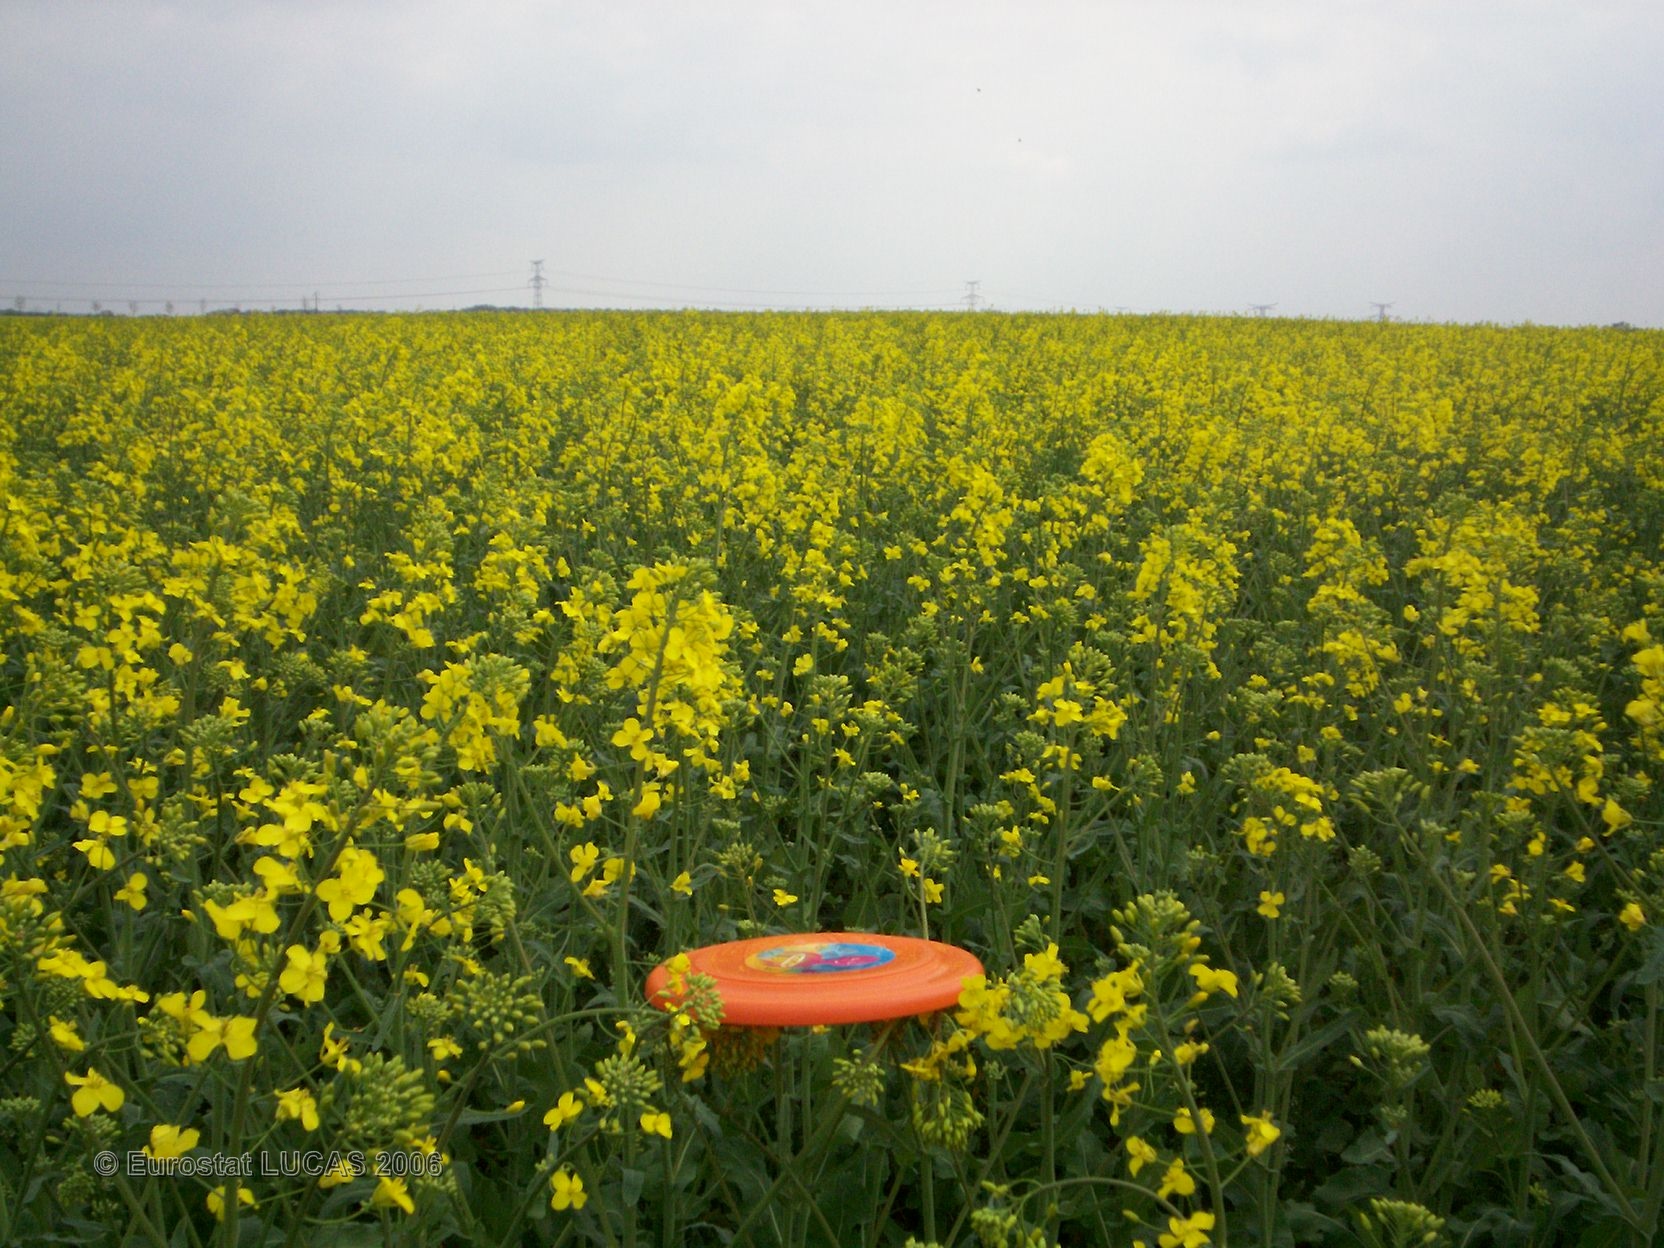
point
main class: Cropland
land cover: Rape and turnip rape
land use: Agriculture (excluding fallow land and kitchen gardens)
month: April
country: FR
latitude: 47.1548
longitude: 3.0447
